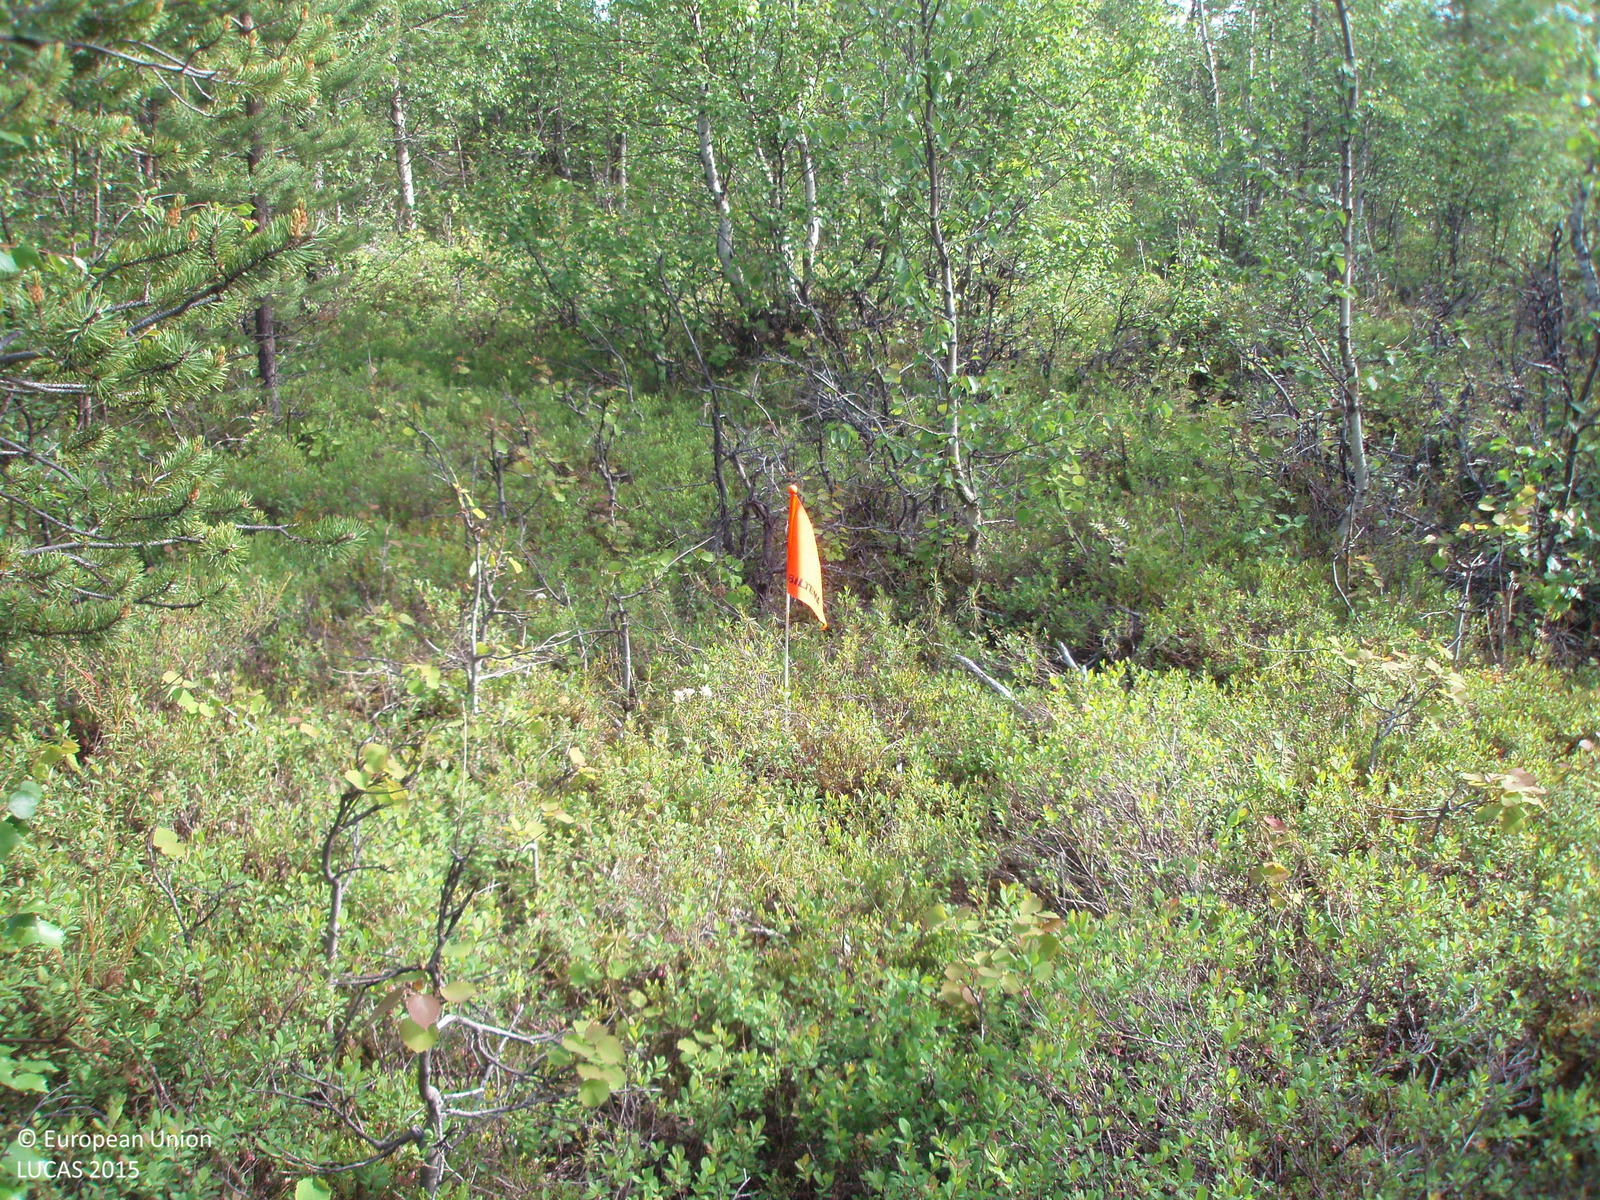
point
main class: Woodland
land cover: Pine dominated mixed woodland
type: boreal forest
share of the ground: > 75 %
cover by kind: coniferous forest trees 40 %, broadleaved forest trees 35 %, shrubs 25 %
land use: Forestry
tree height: > 5 m
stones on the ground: 10 - 25 %
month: July
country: FI
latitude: 67.7375
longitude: 27.7215
